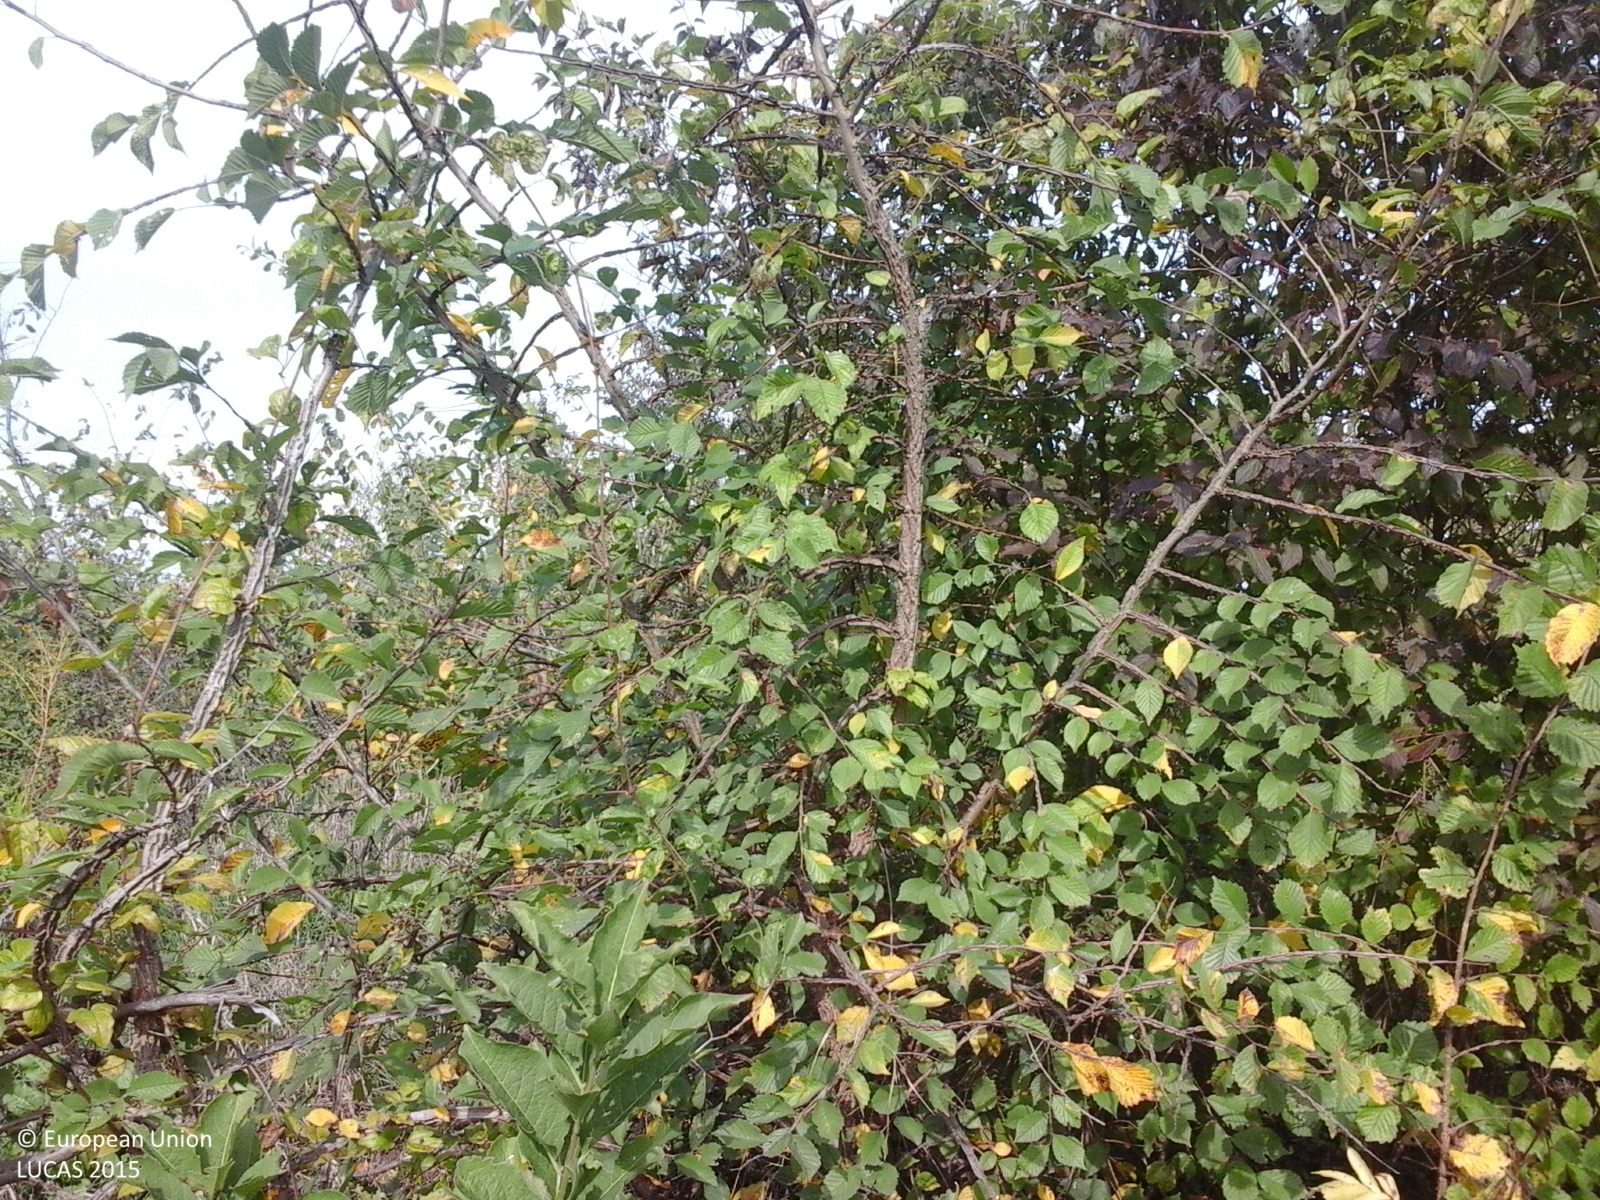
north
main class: Grassland
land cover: Grassland with sparse tree/shrub cover
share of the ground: > 75 %
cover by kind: herbaceous plants 85 %, shrubs 10 %, broadleaved forest trees 5 %
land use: Fallow land
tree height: < 5 m
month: October
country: RO
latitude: 44.9921
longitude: 26.1054
